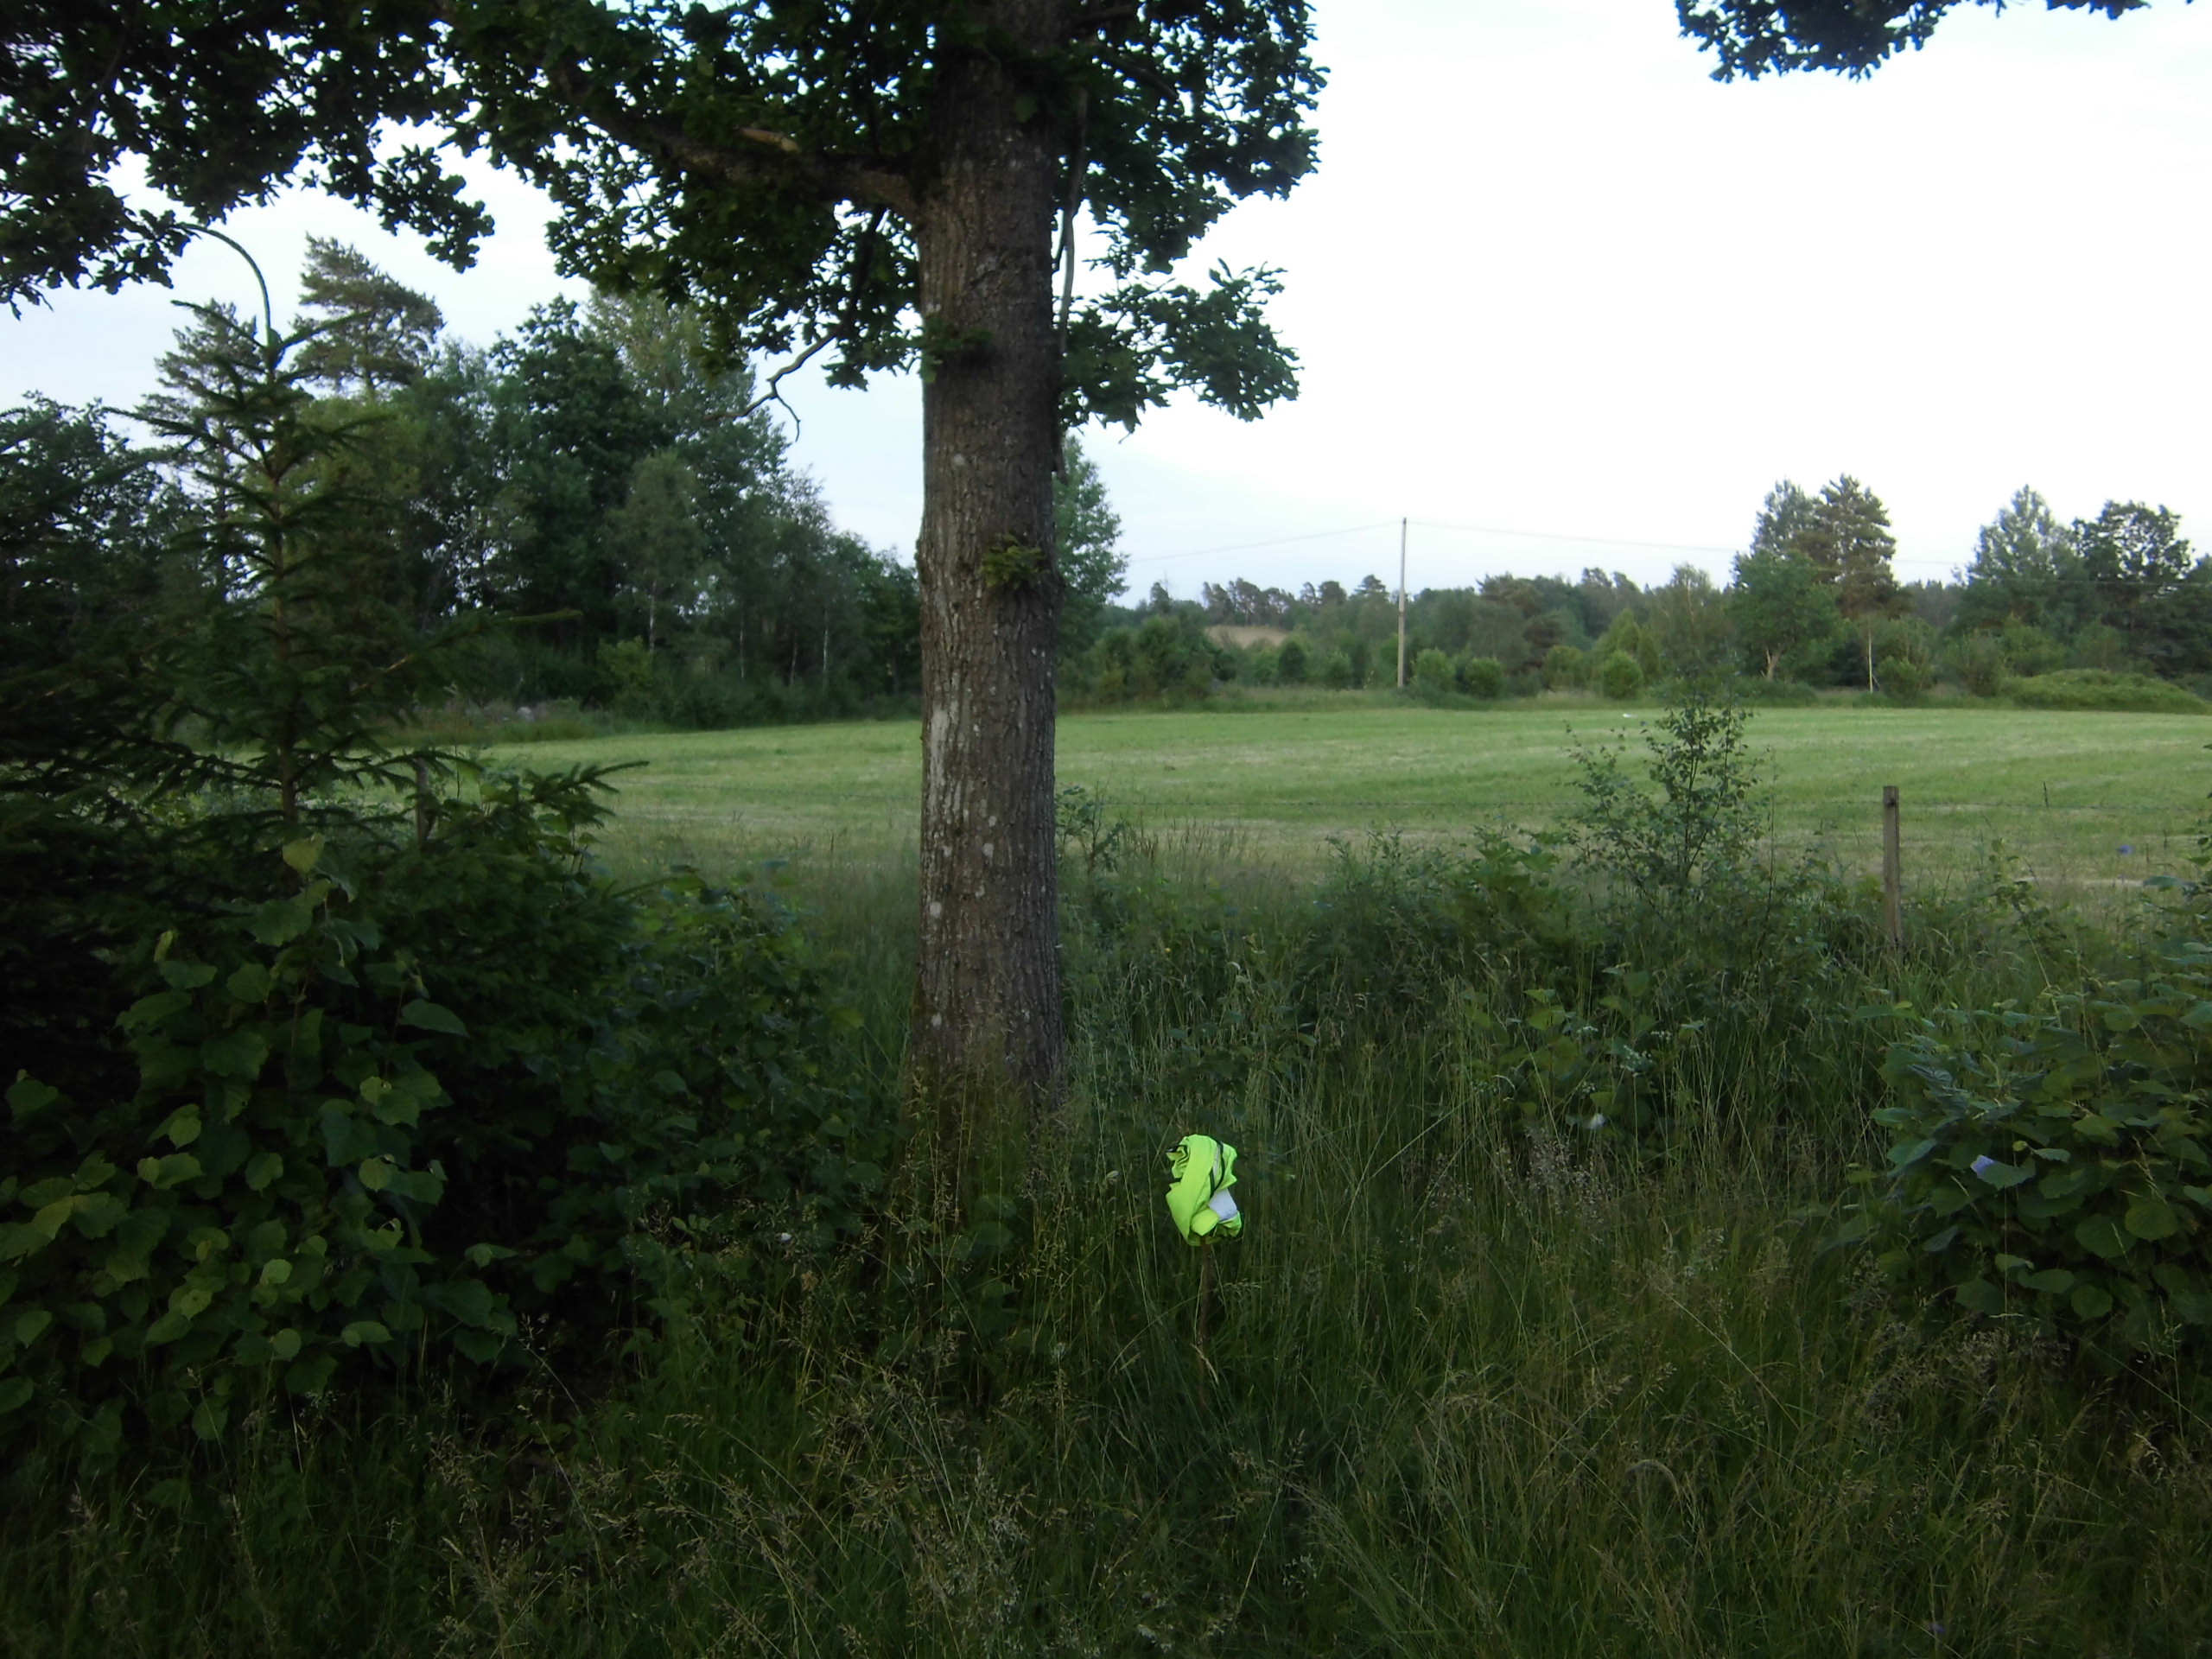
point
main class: Woodland
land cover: Broadleaved woodland
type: hemiboreal forest and nemoral coniferous forest and mixed broadleaved-coniferous forest
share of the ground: 50 - 75 %
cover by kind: broadleaved forest trees 50 %, herbaceous plants 30 %, shrubs 10 %, coniferous forest trees 5 %, lichens and mosses 5 %
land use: Forestry
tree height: > 5 m
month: July
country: SE
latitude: 57.2861
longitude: 14.8241
